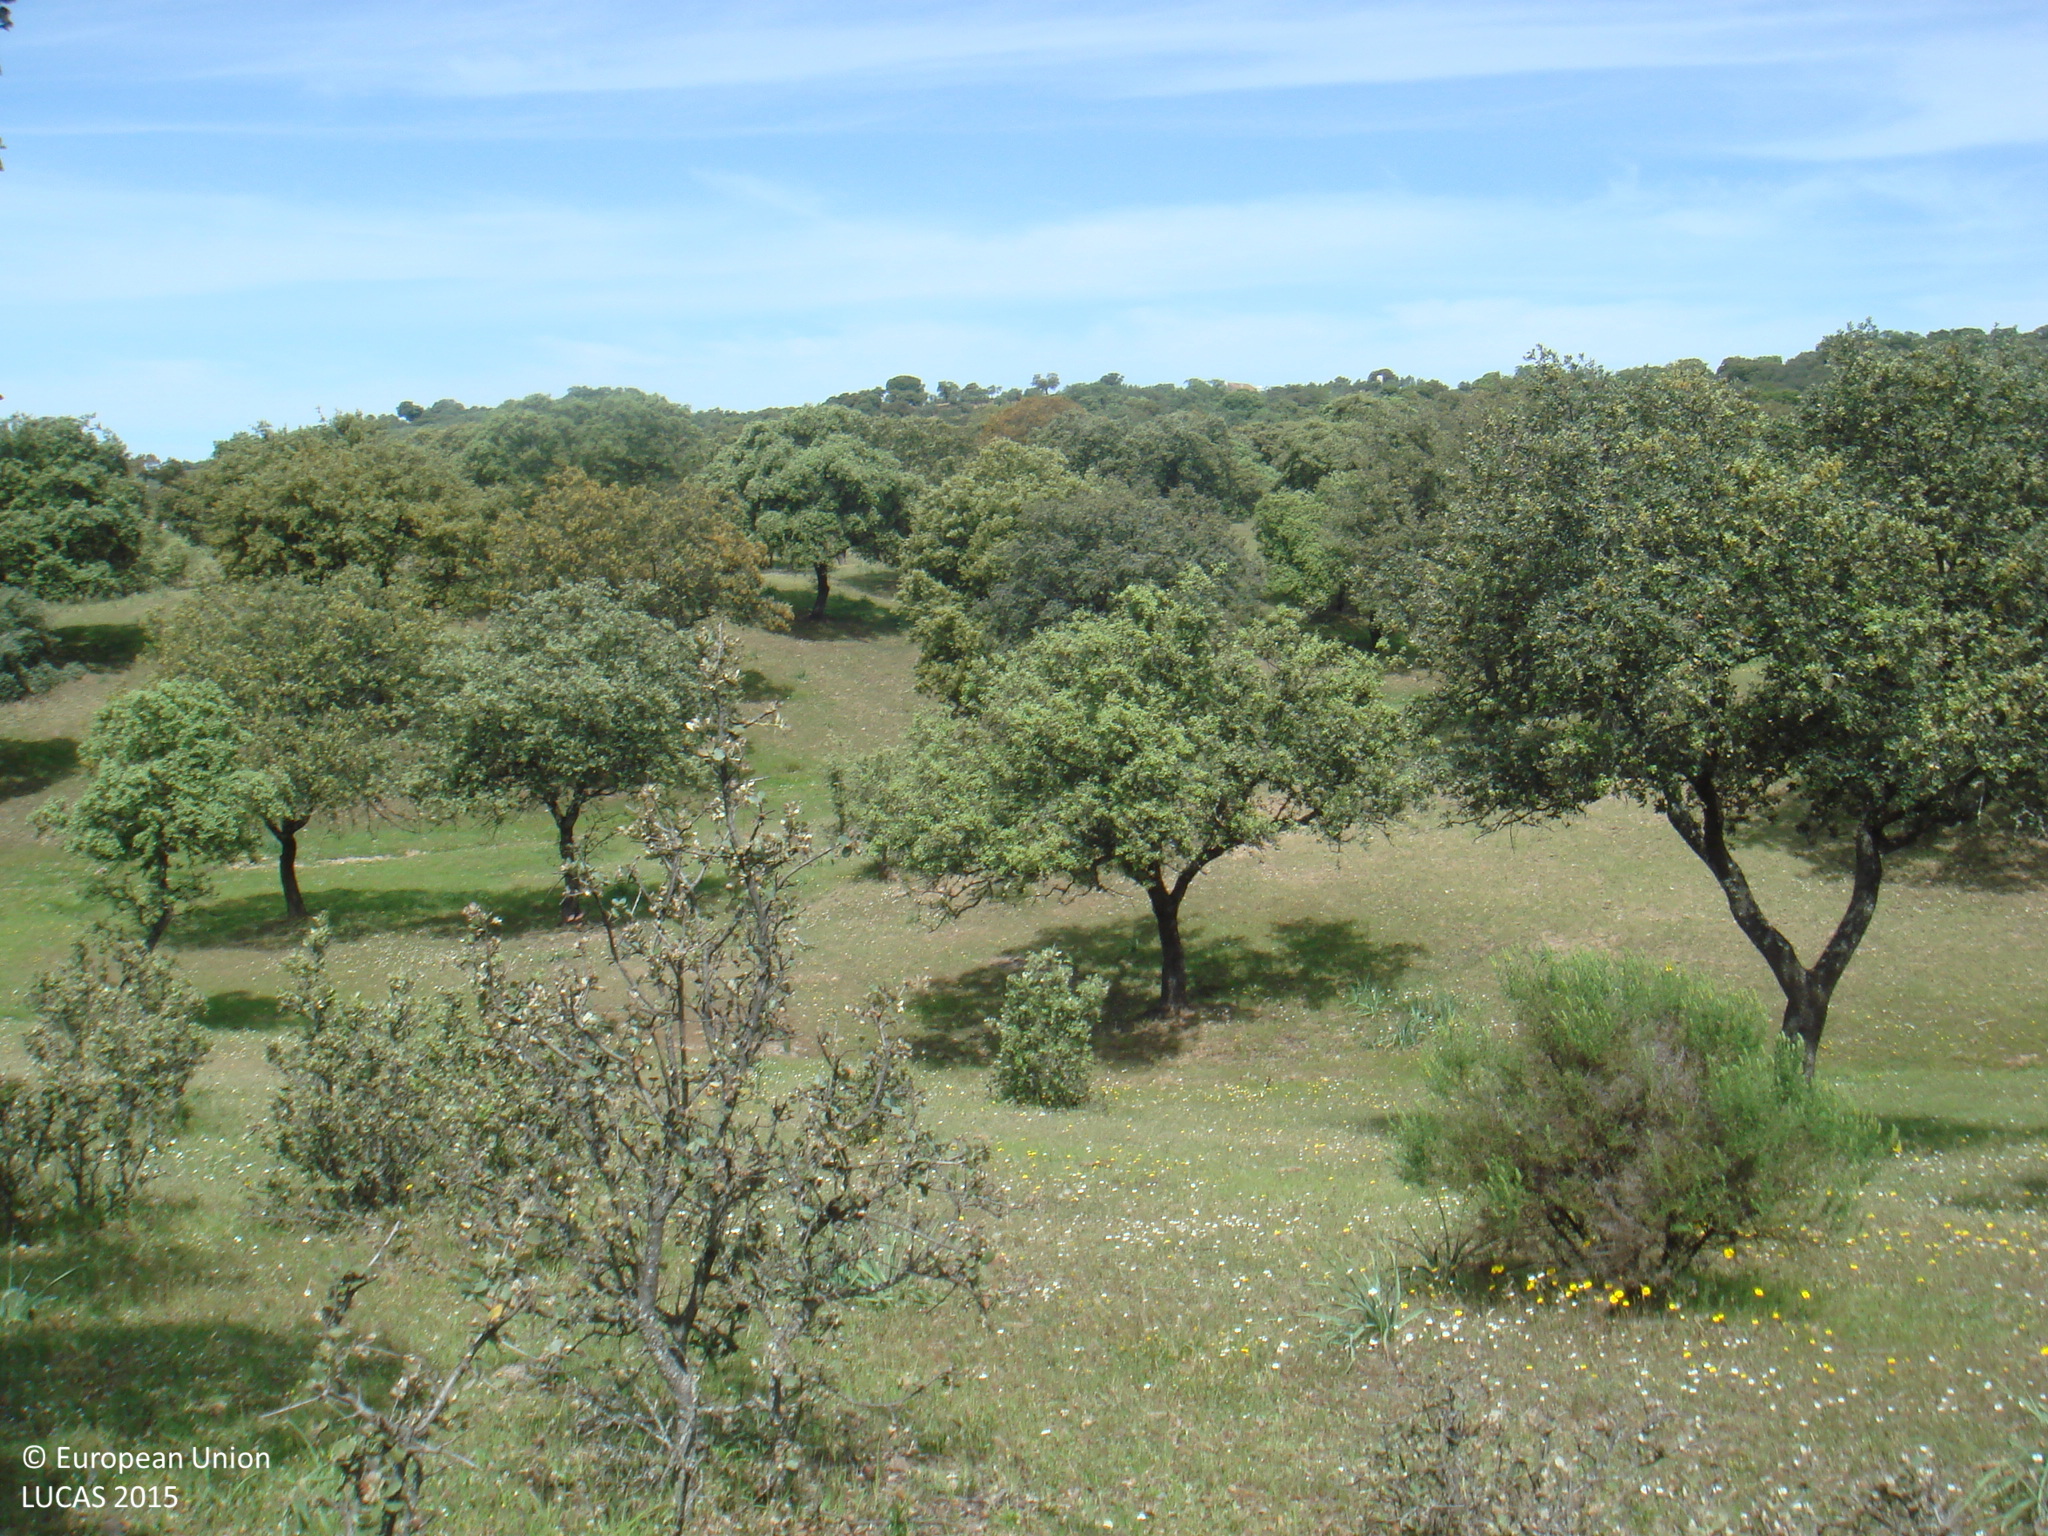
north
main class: Woodland
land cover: Broadleaved woodland
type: broadleaved evergreen forest
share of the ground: > 75 %
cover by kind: broadleaved forest trees 80 %, coniferous forest trees 20 %
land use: Forestry
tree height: > 5 m
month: April
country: ES
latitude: 38.1817
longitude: -4.6879
